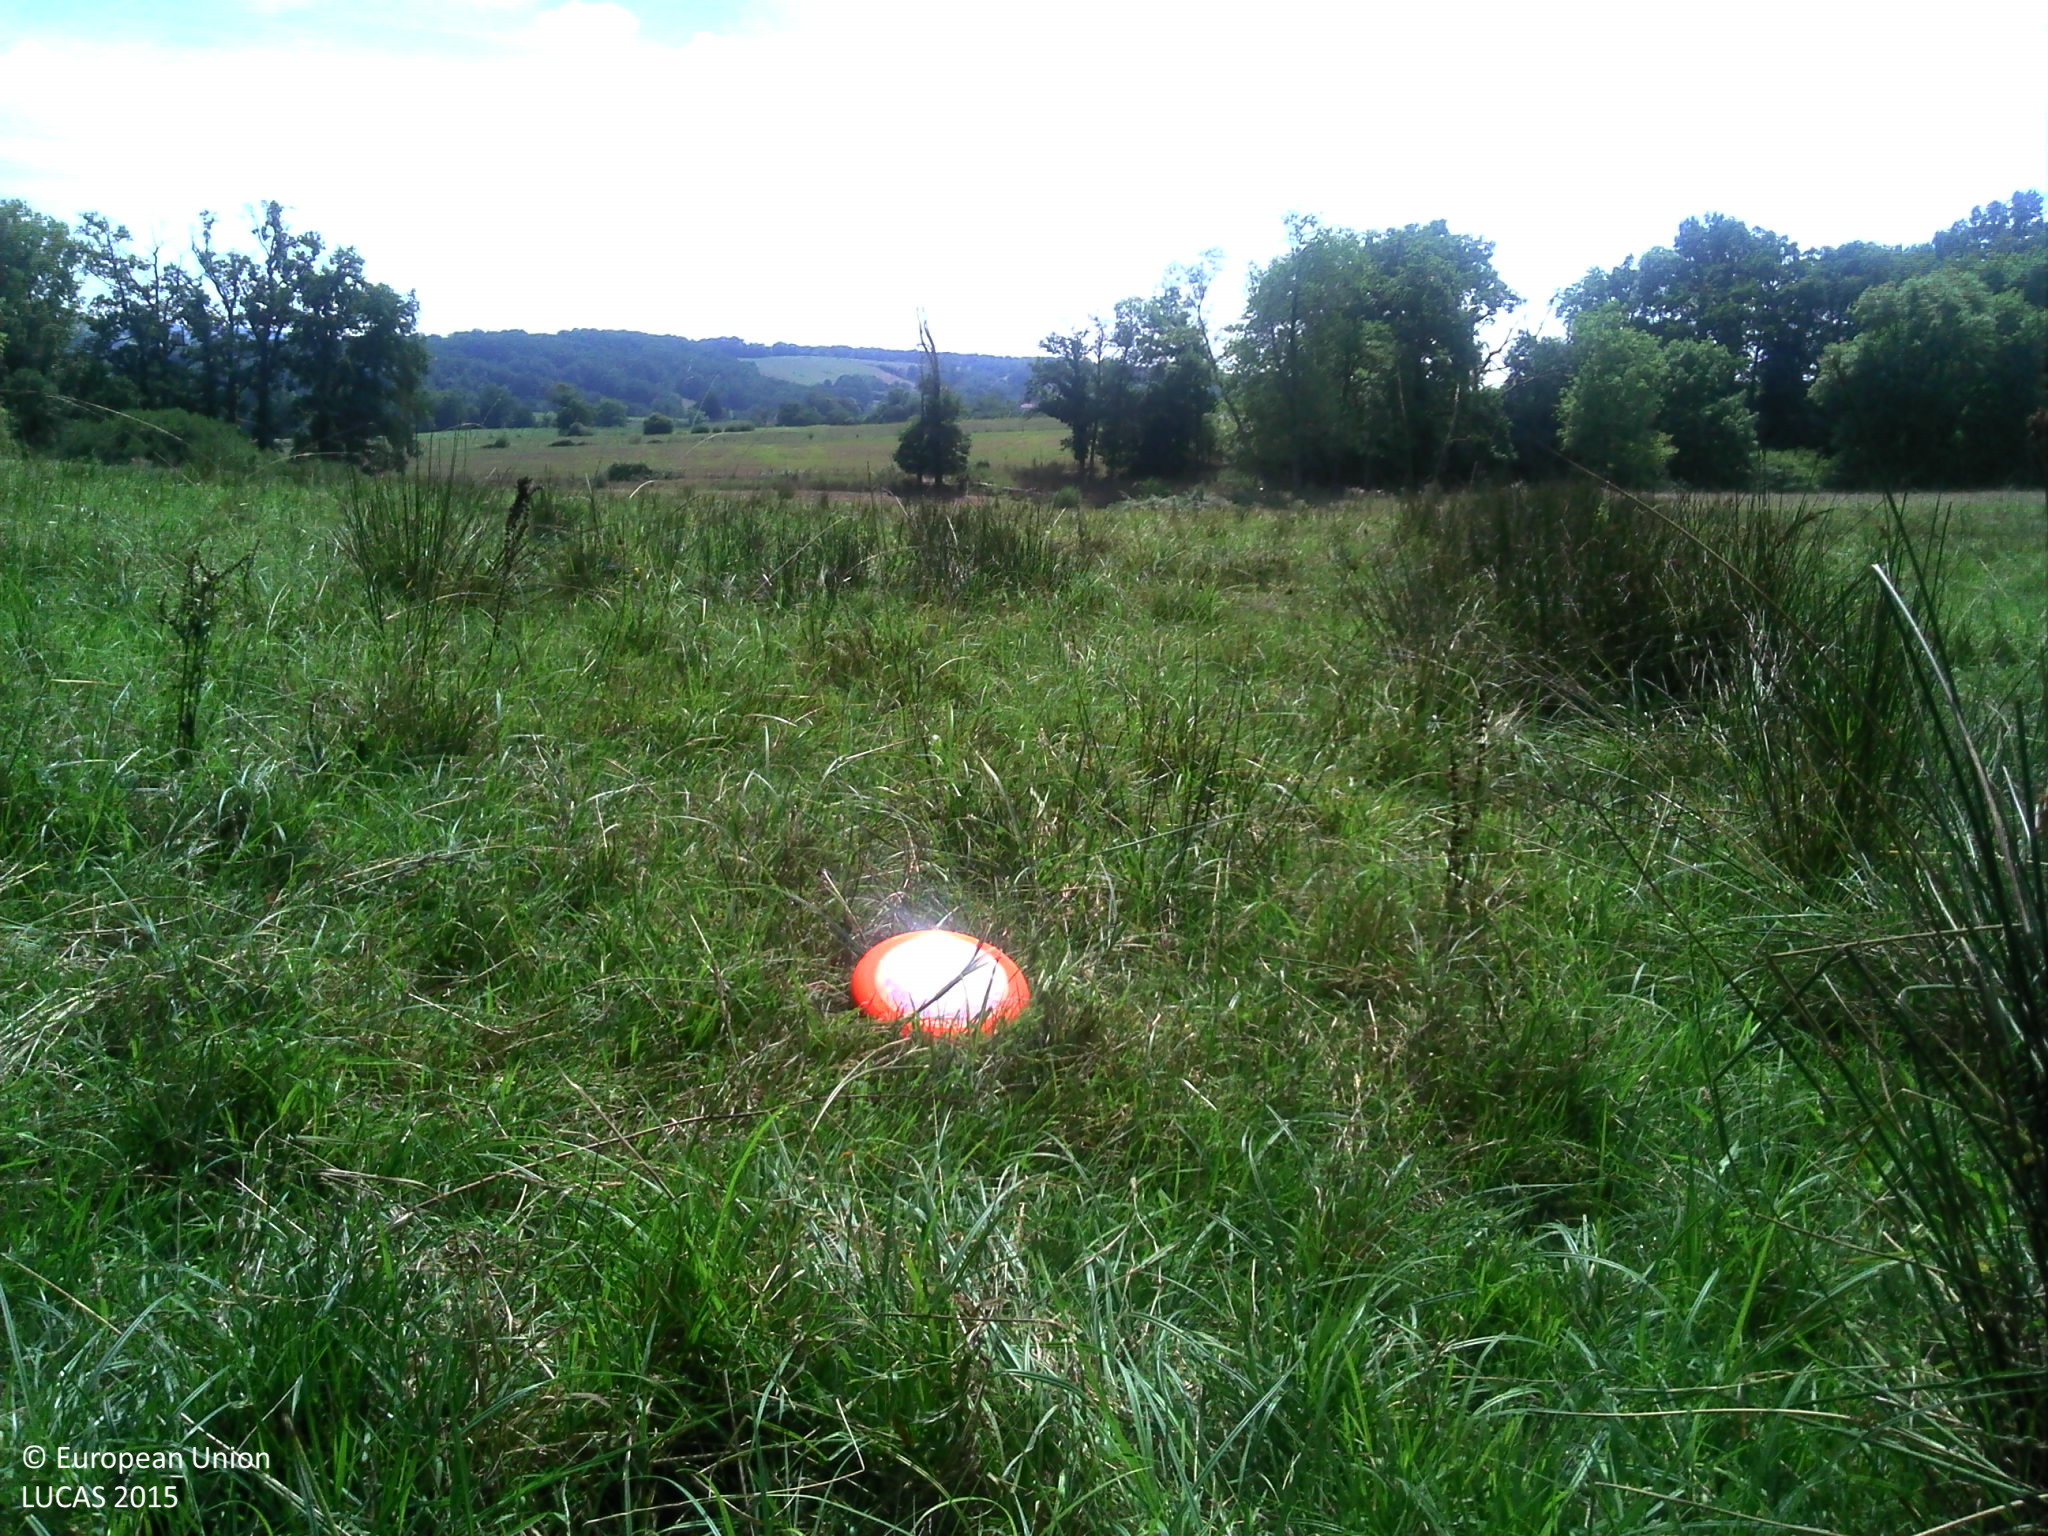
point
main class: Grassland
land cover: Grassland without tree/shrub cover
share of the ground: > 75 %
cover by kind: herbaceous plants 95 %
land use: Agriculture (excluding fallow land and kitchen gardens)
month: August
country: FR
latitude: 45.6882
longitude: 1.2986
